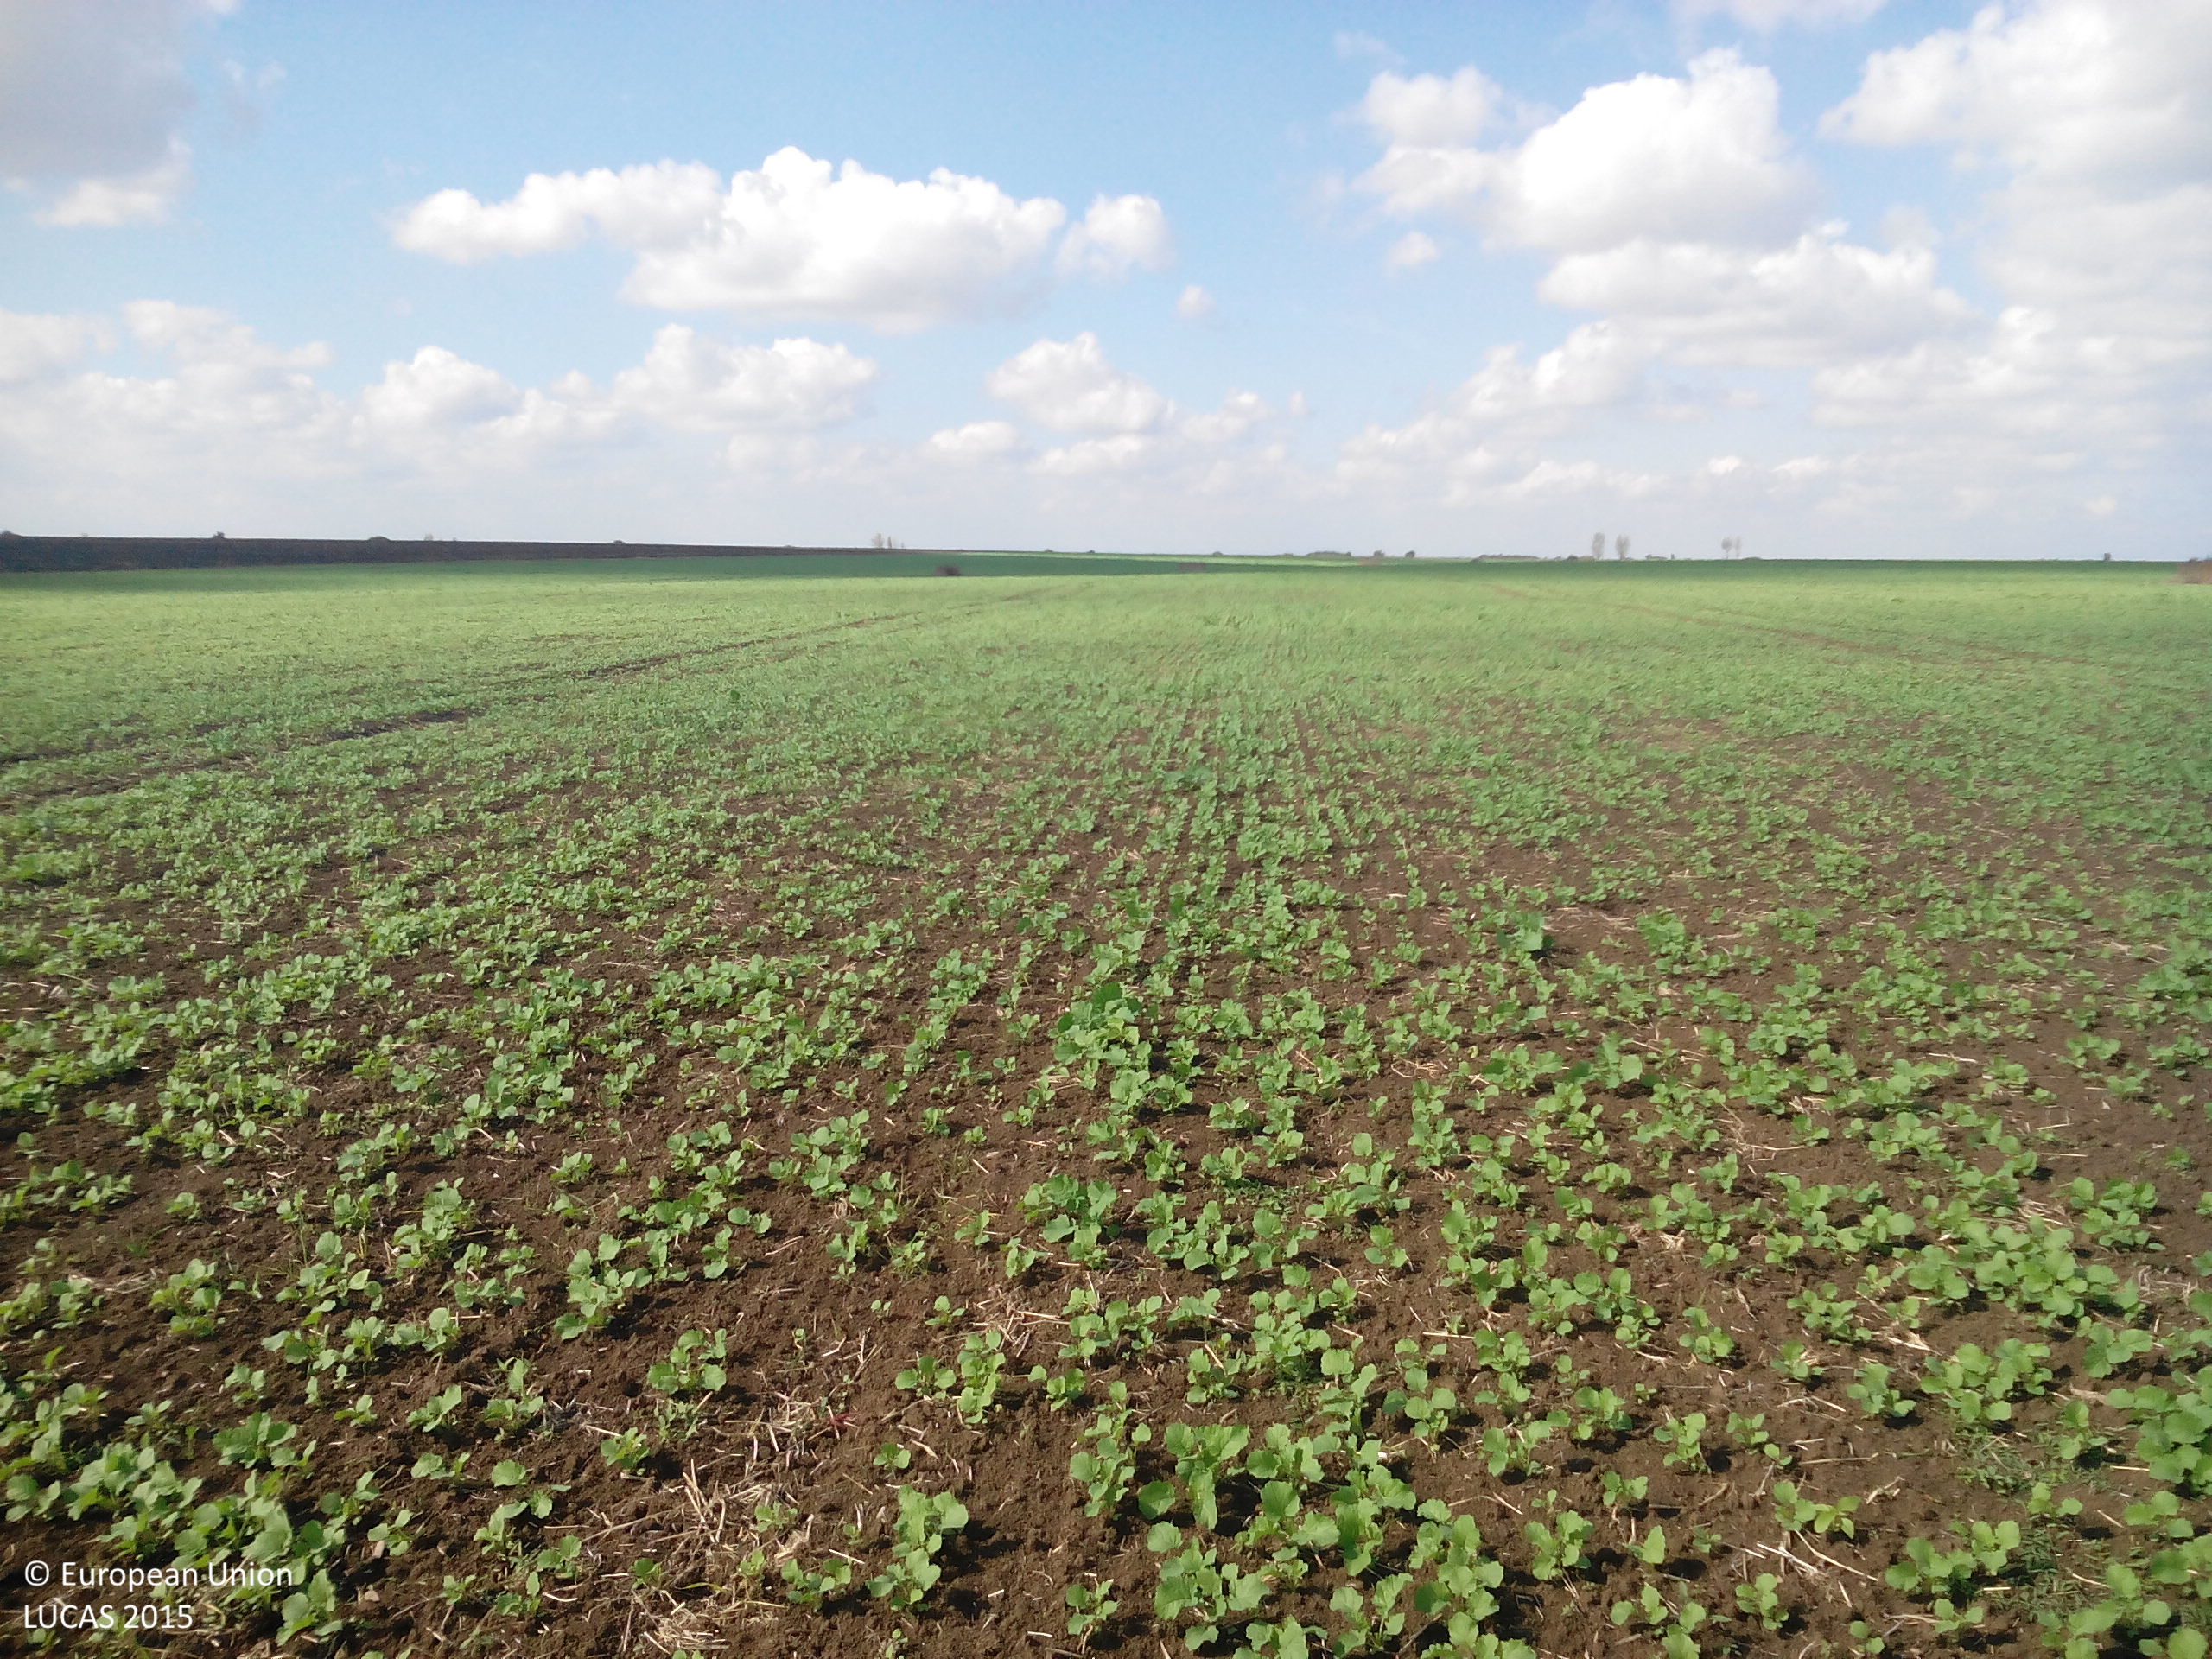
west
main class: Cropland
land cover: Rape and turnip rape
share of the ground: 25 - 50 %
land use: Agriculture (excluding fallow land and kitchen gardens)
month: October
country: BG
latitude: 43.3996
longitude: 23.8408
